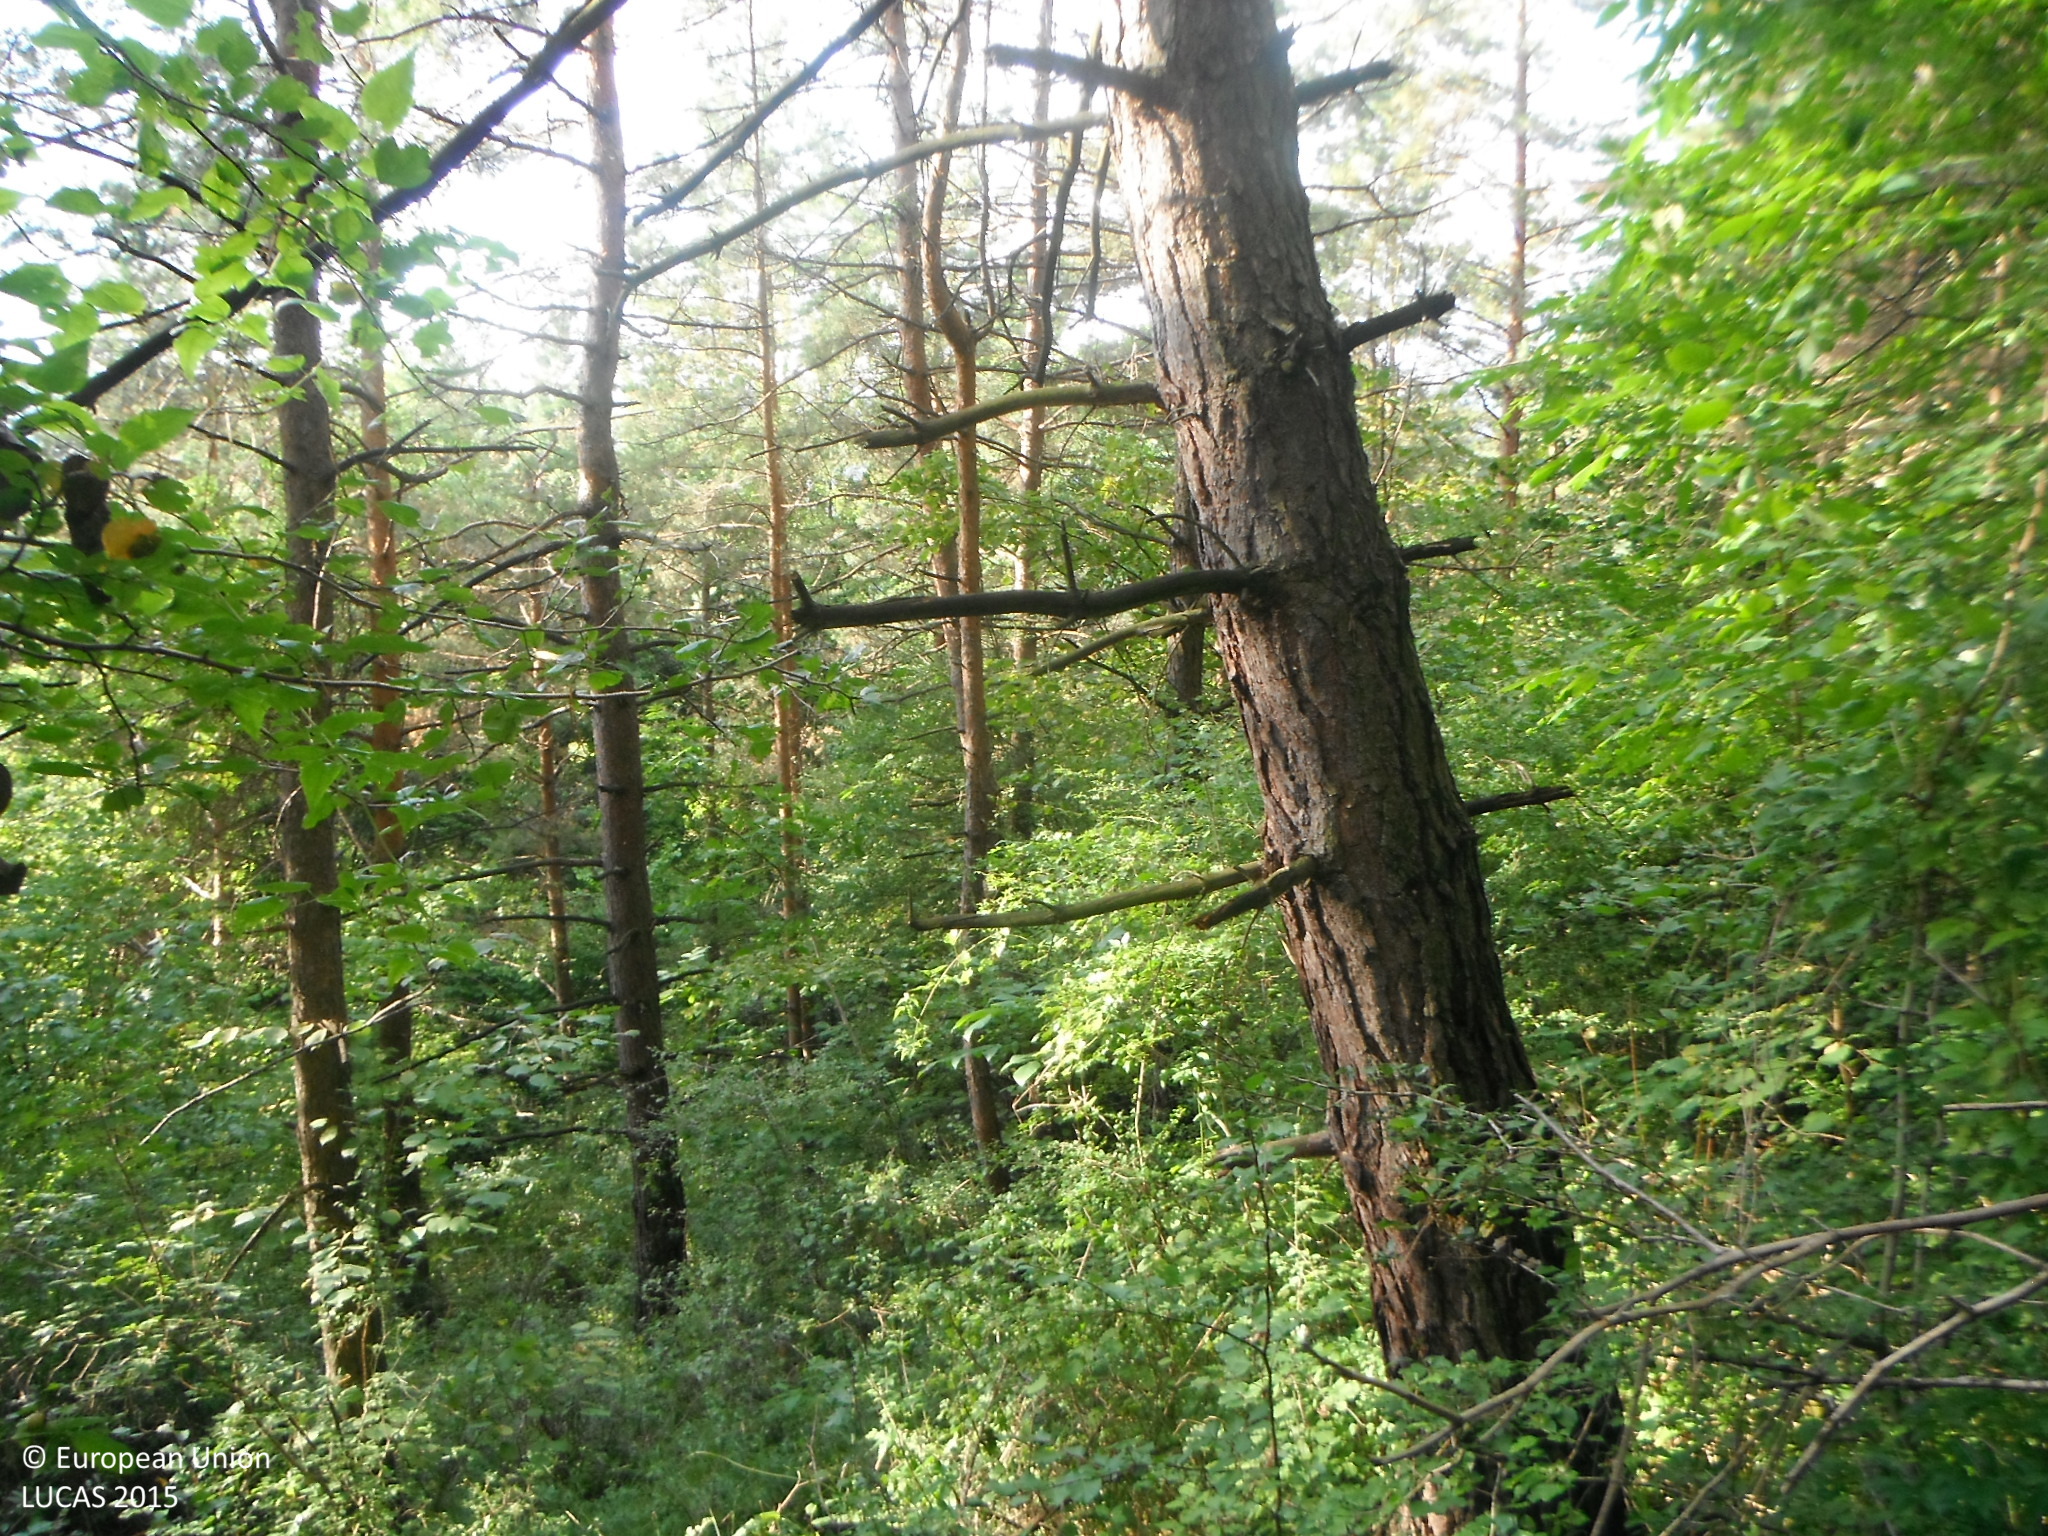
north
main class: Woodland
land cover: Pine dominated coniferous woodland
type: hemiboreal forest and nemoral coniferous forest and mixed broadleaved-coniferous forest
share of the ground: > 75 %
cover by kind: coniferous forest trees 90 %, broadleaved forest trees 10 %
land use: Forestry
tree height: > 5 m
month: August
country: SK
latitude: 48.8276
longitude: 18.3667
